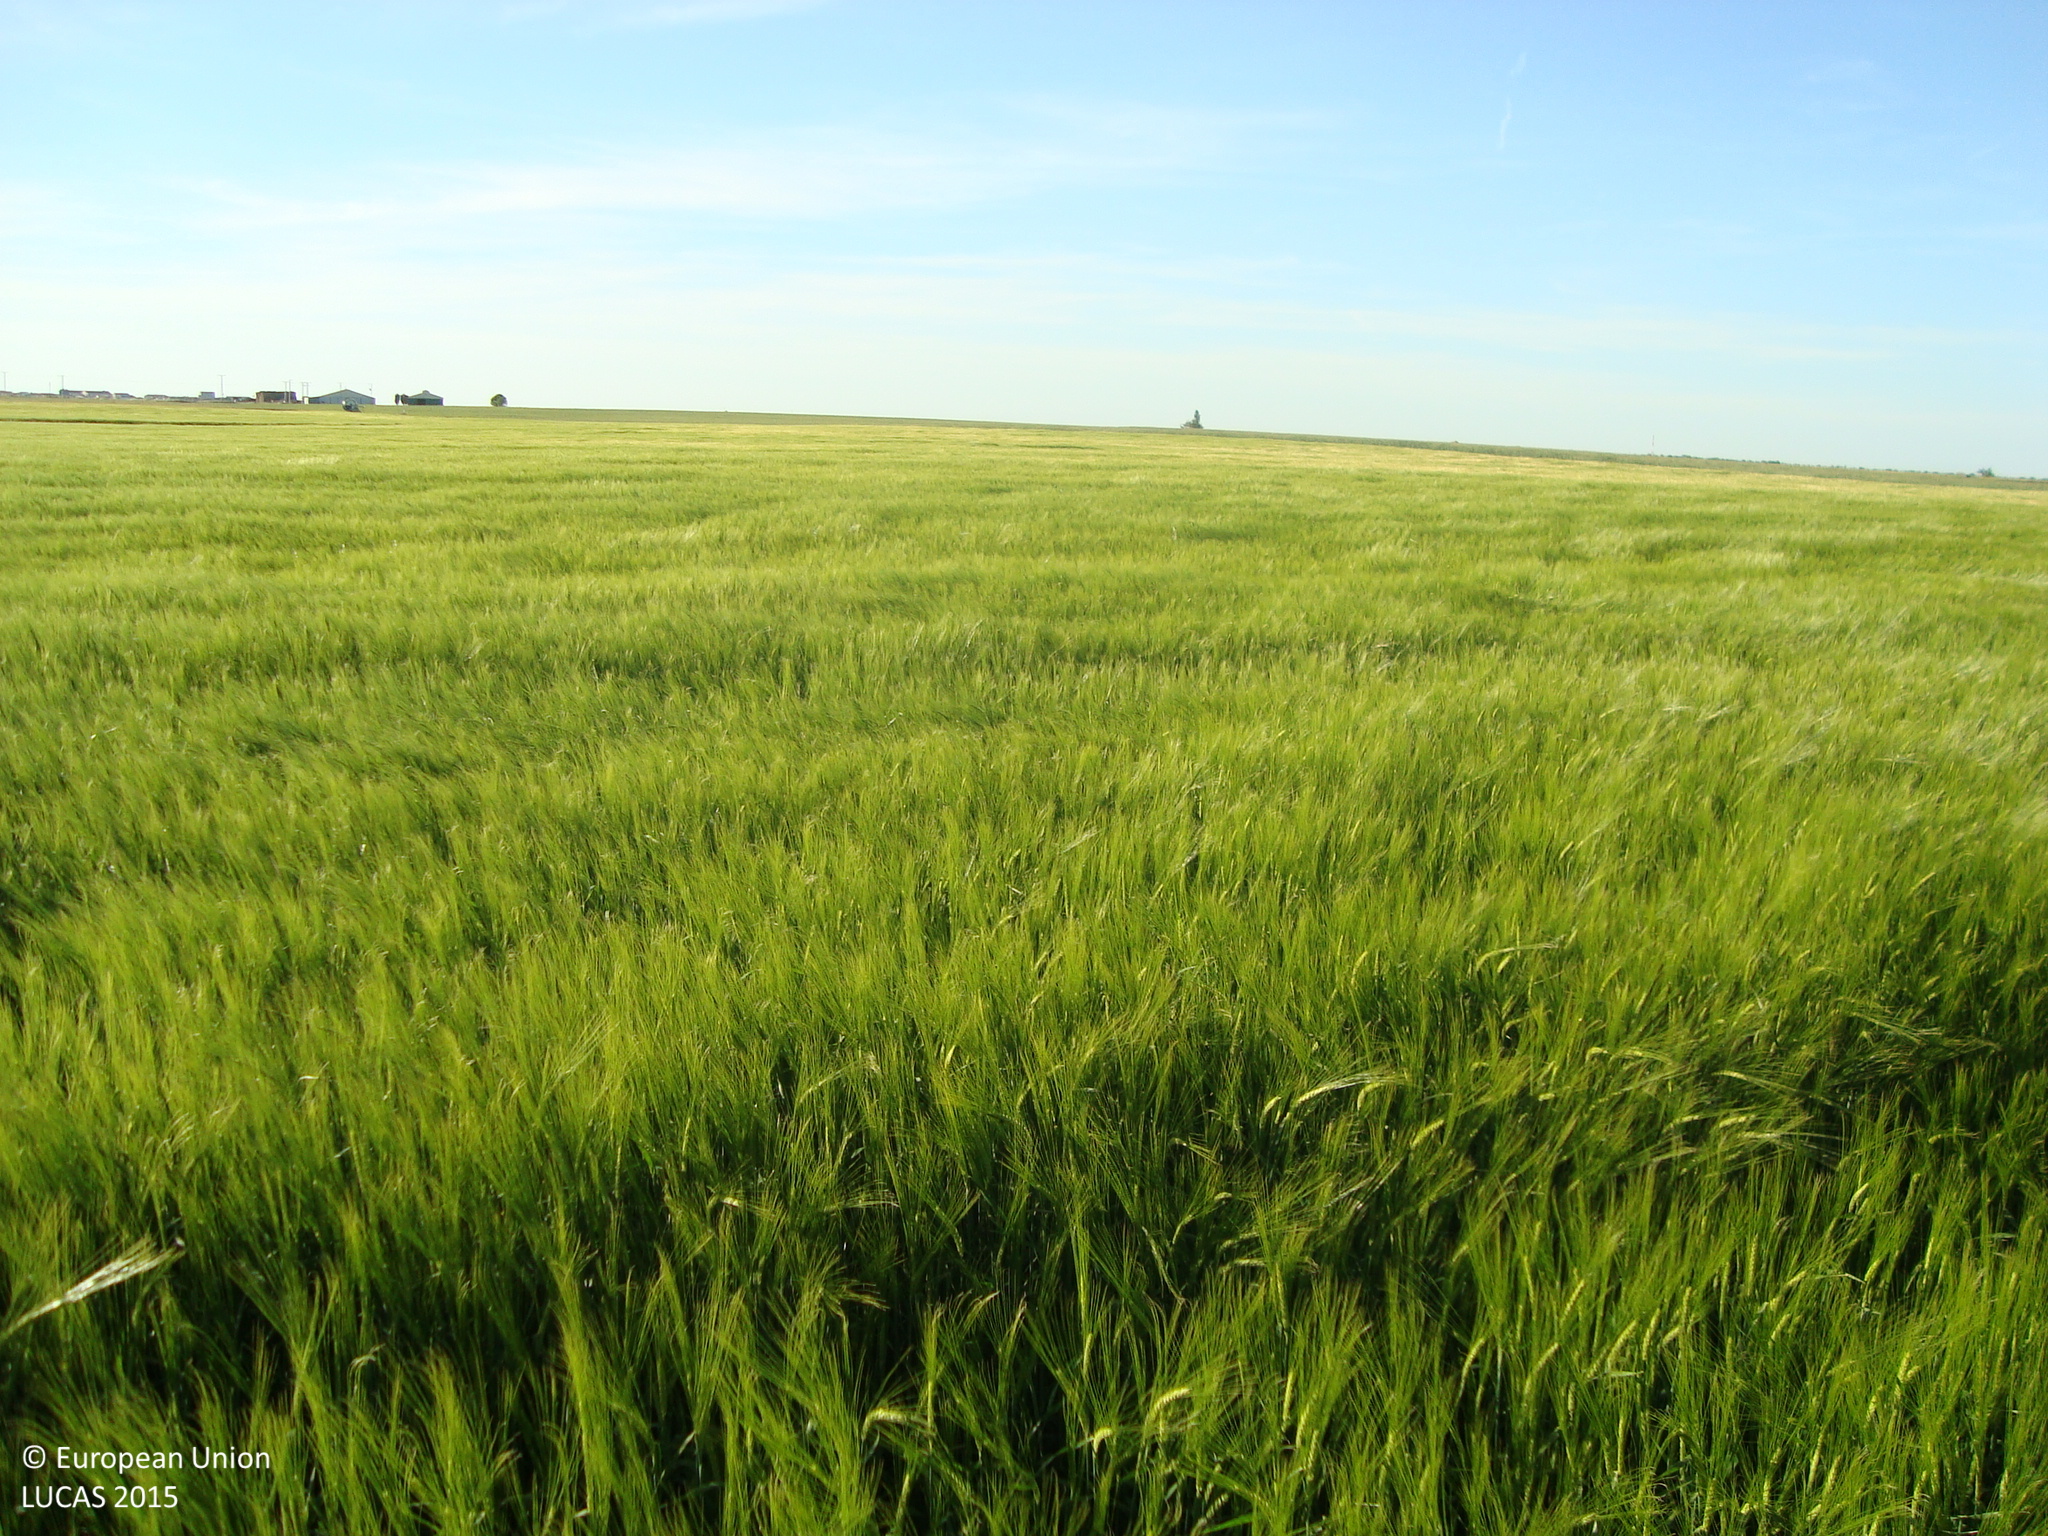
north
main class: Cropland
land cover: Barley
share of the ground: > 75 %
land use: Agriculture (excluding fallow land and kitchen gardens)
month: May
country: ES
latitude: 41.4683
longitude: -4.1746
